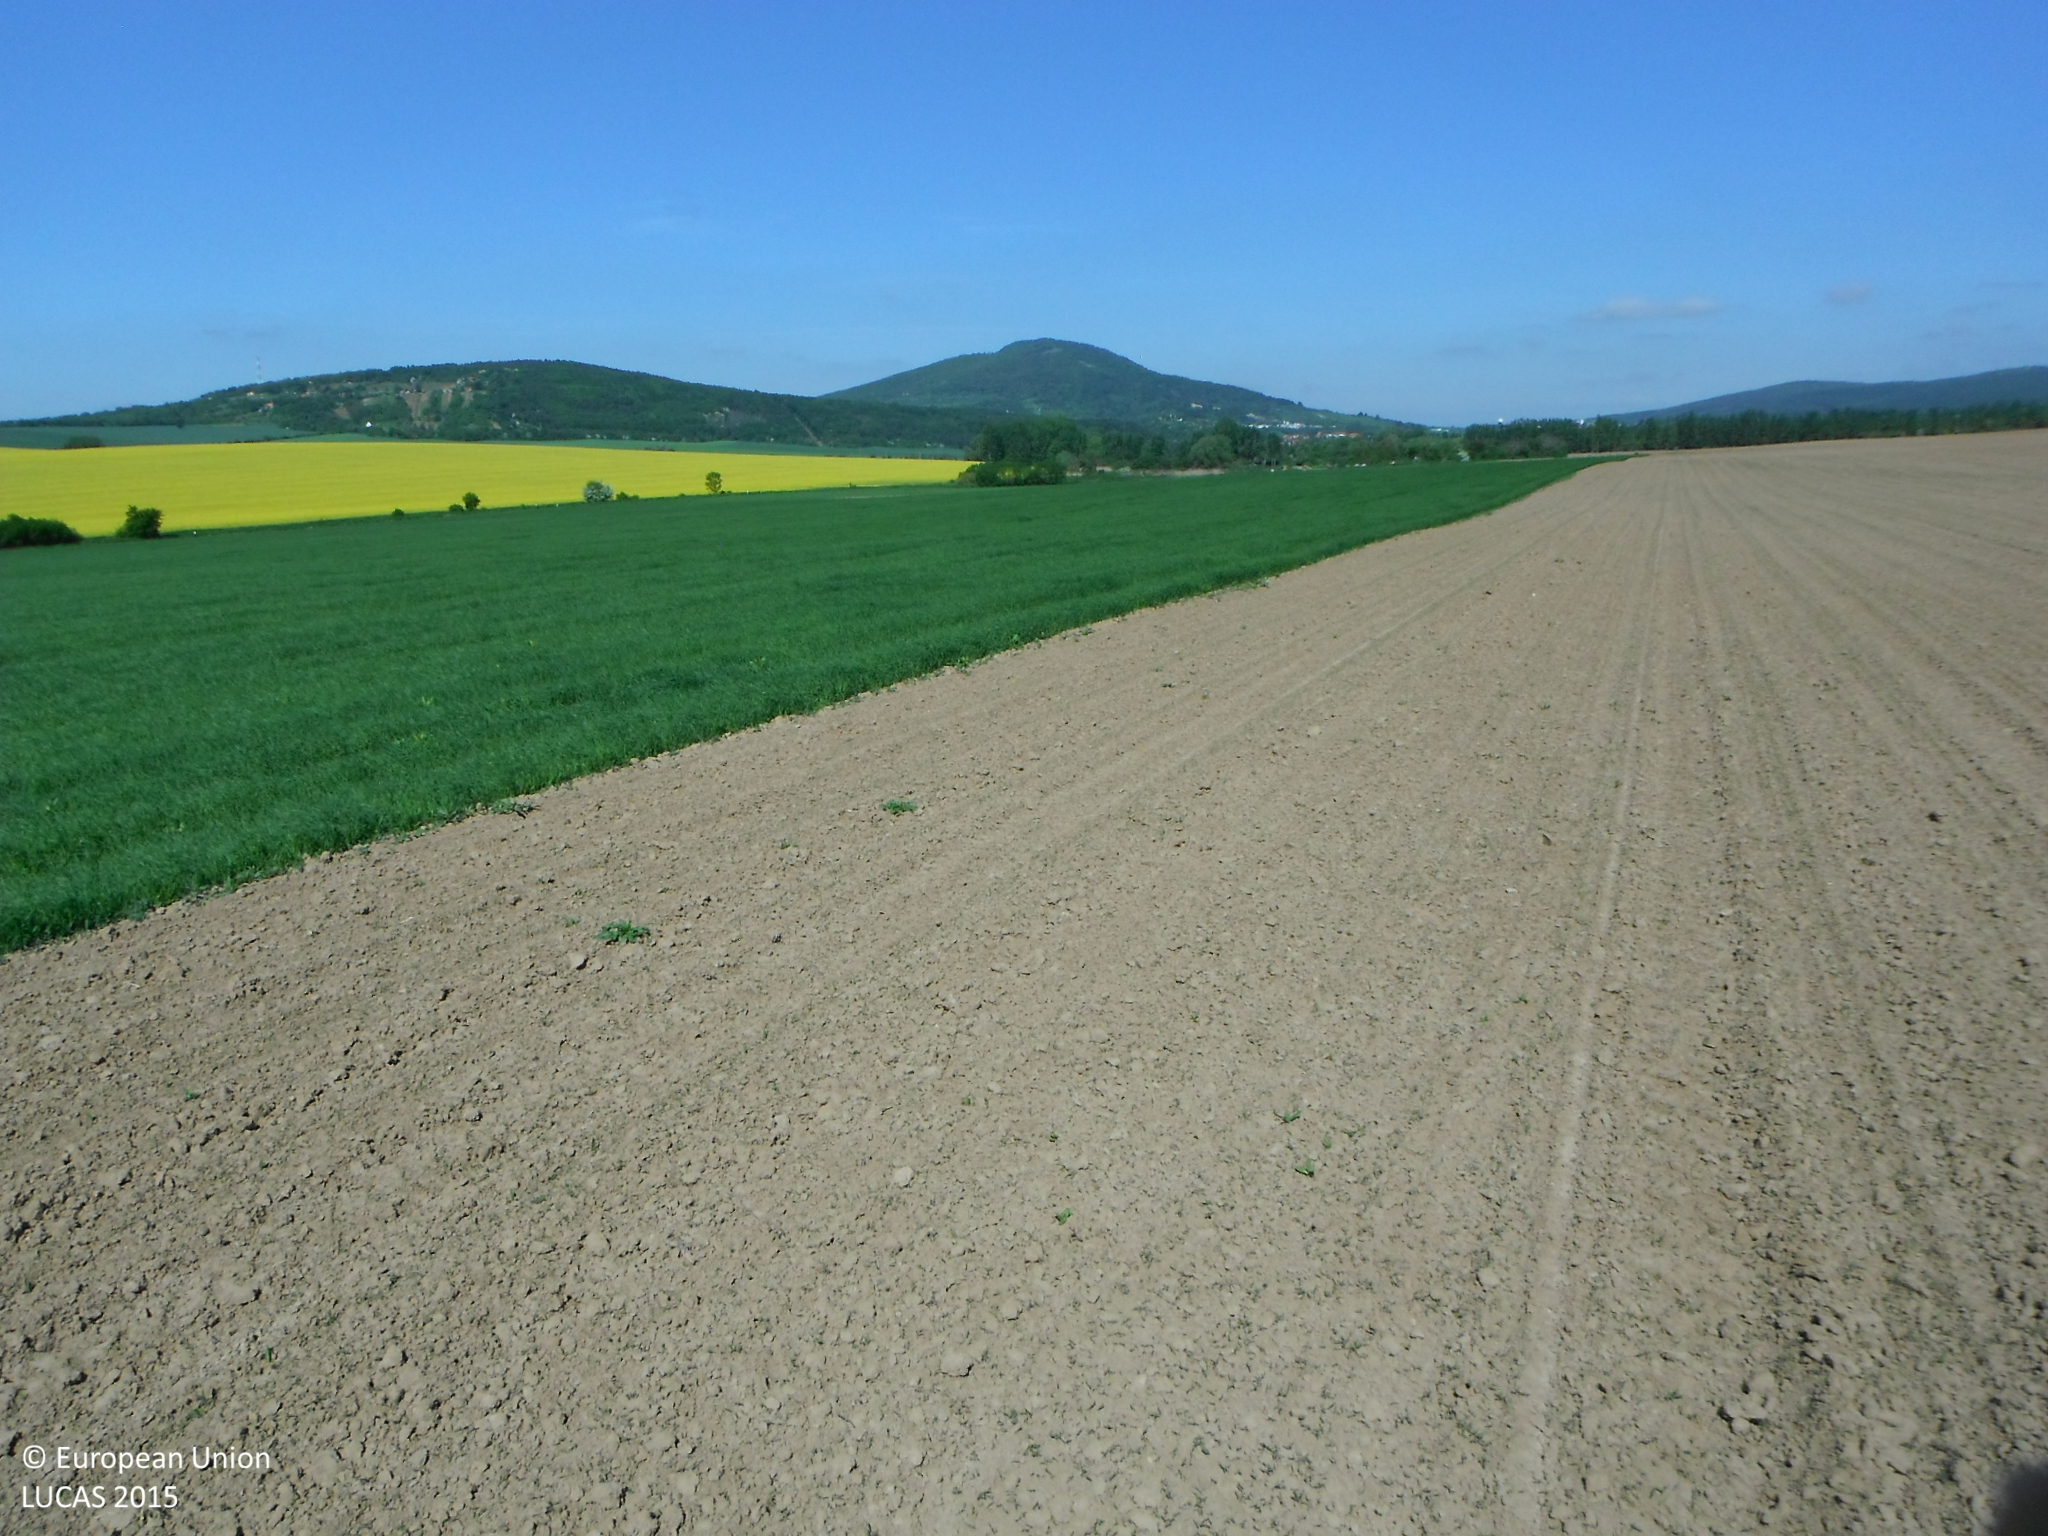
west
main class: Cropland
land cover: Maize
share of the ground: < 10 %
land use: Agriculture (excluding fallow land and kitchen gardens)
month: May
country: SK
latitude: 48.3493
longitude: 18.2324
